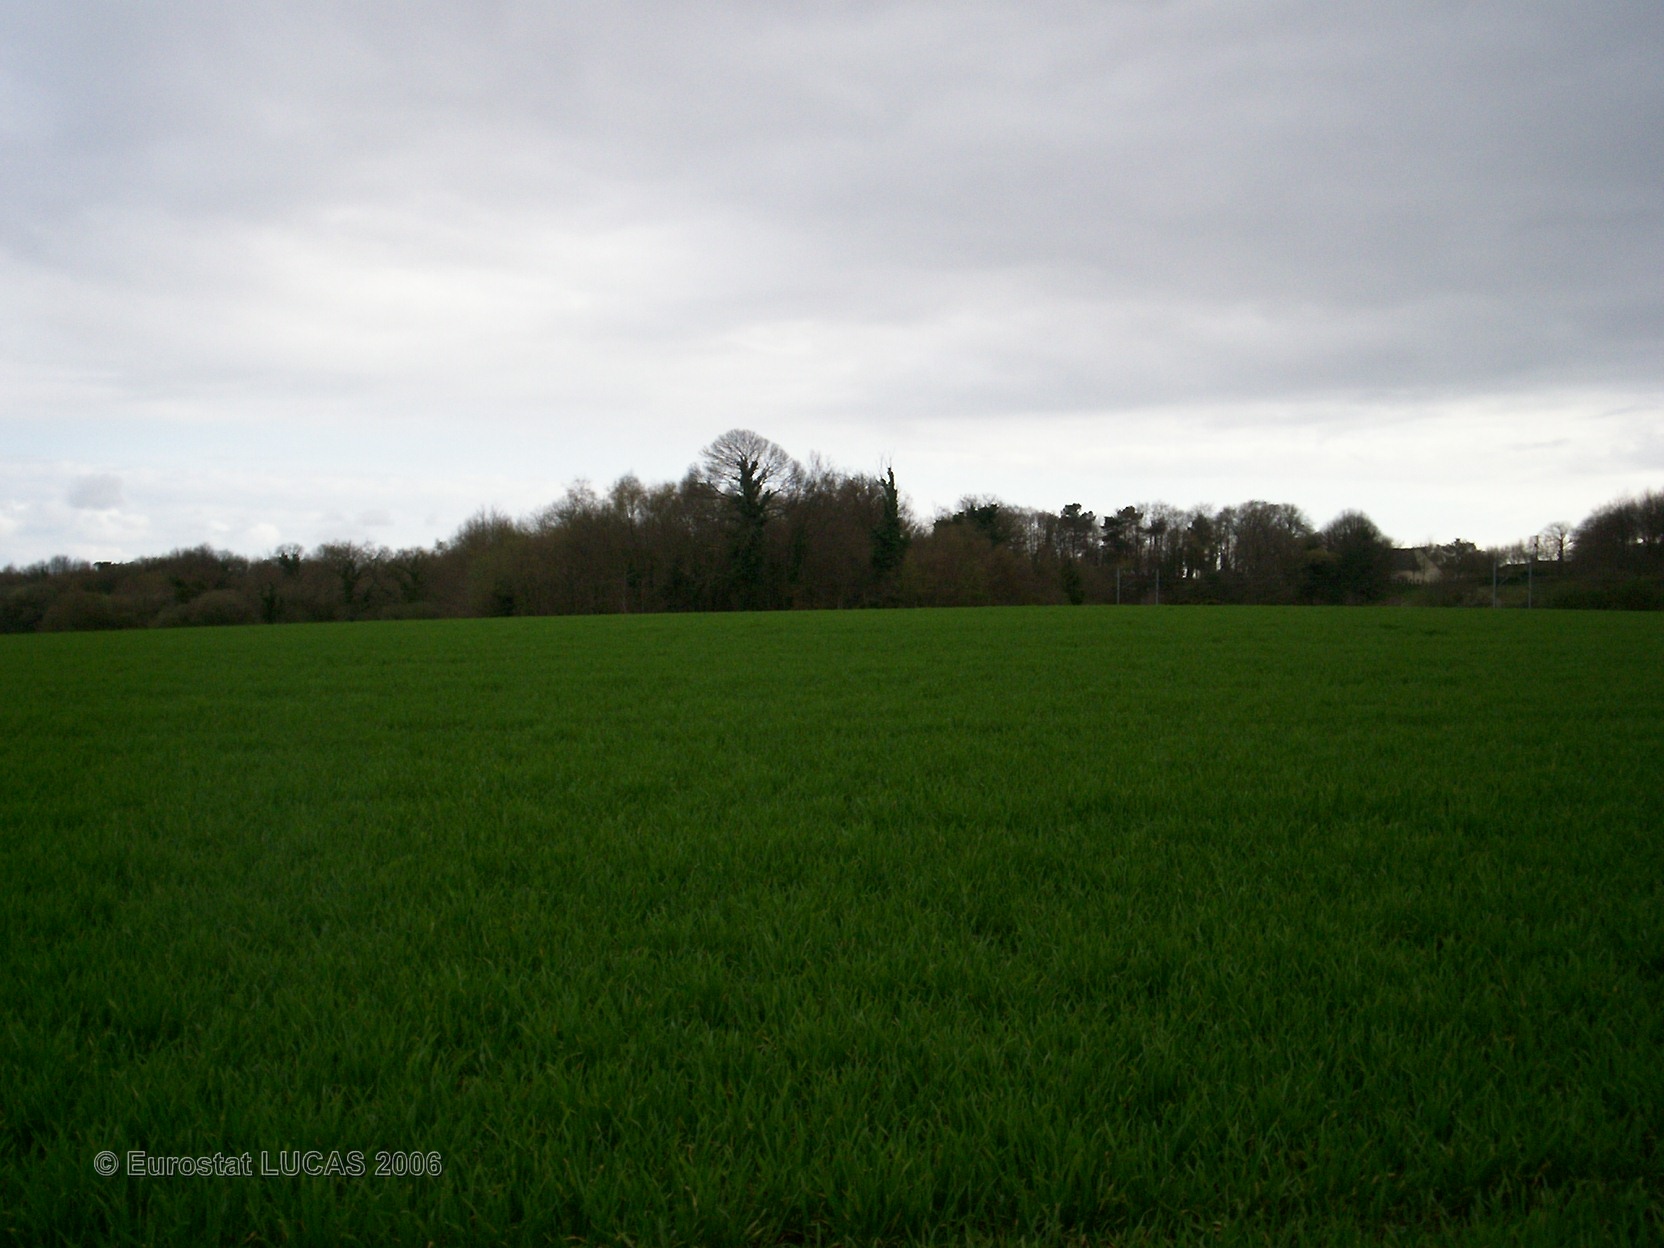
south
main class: Cropland
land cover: Common wheat
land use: Agriculture (excluding fallow land and kitchen gardens)
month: April
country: FR
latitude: 47.8295
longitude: -3.4740
